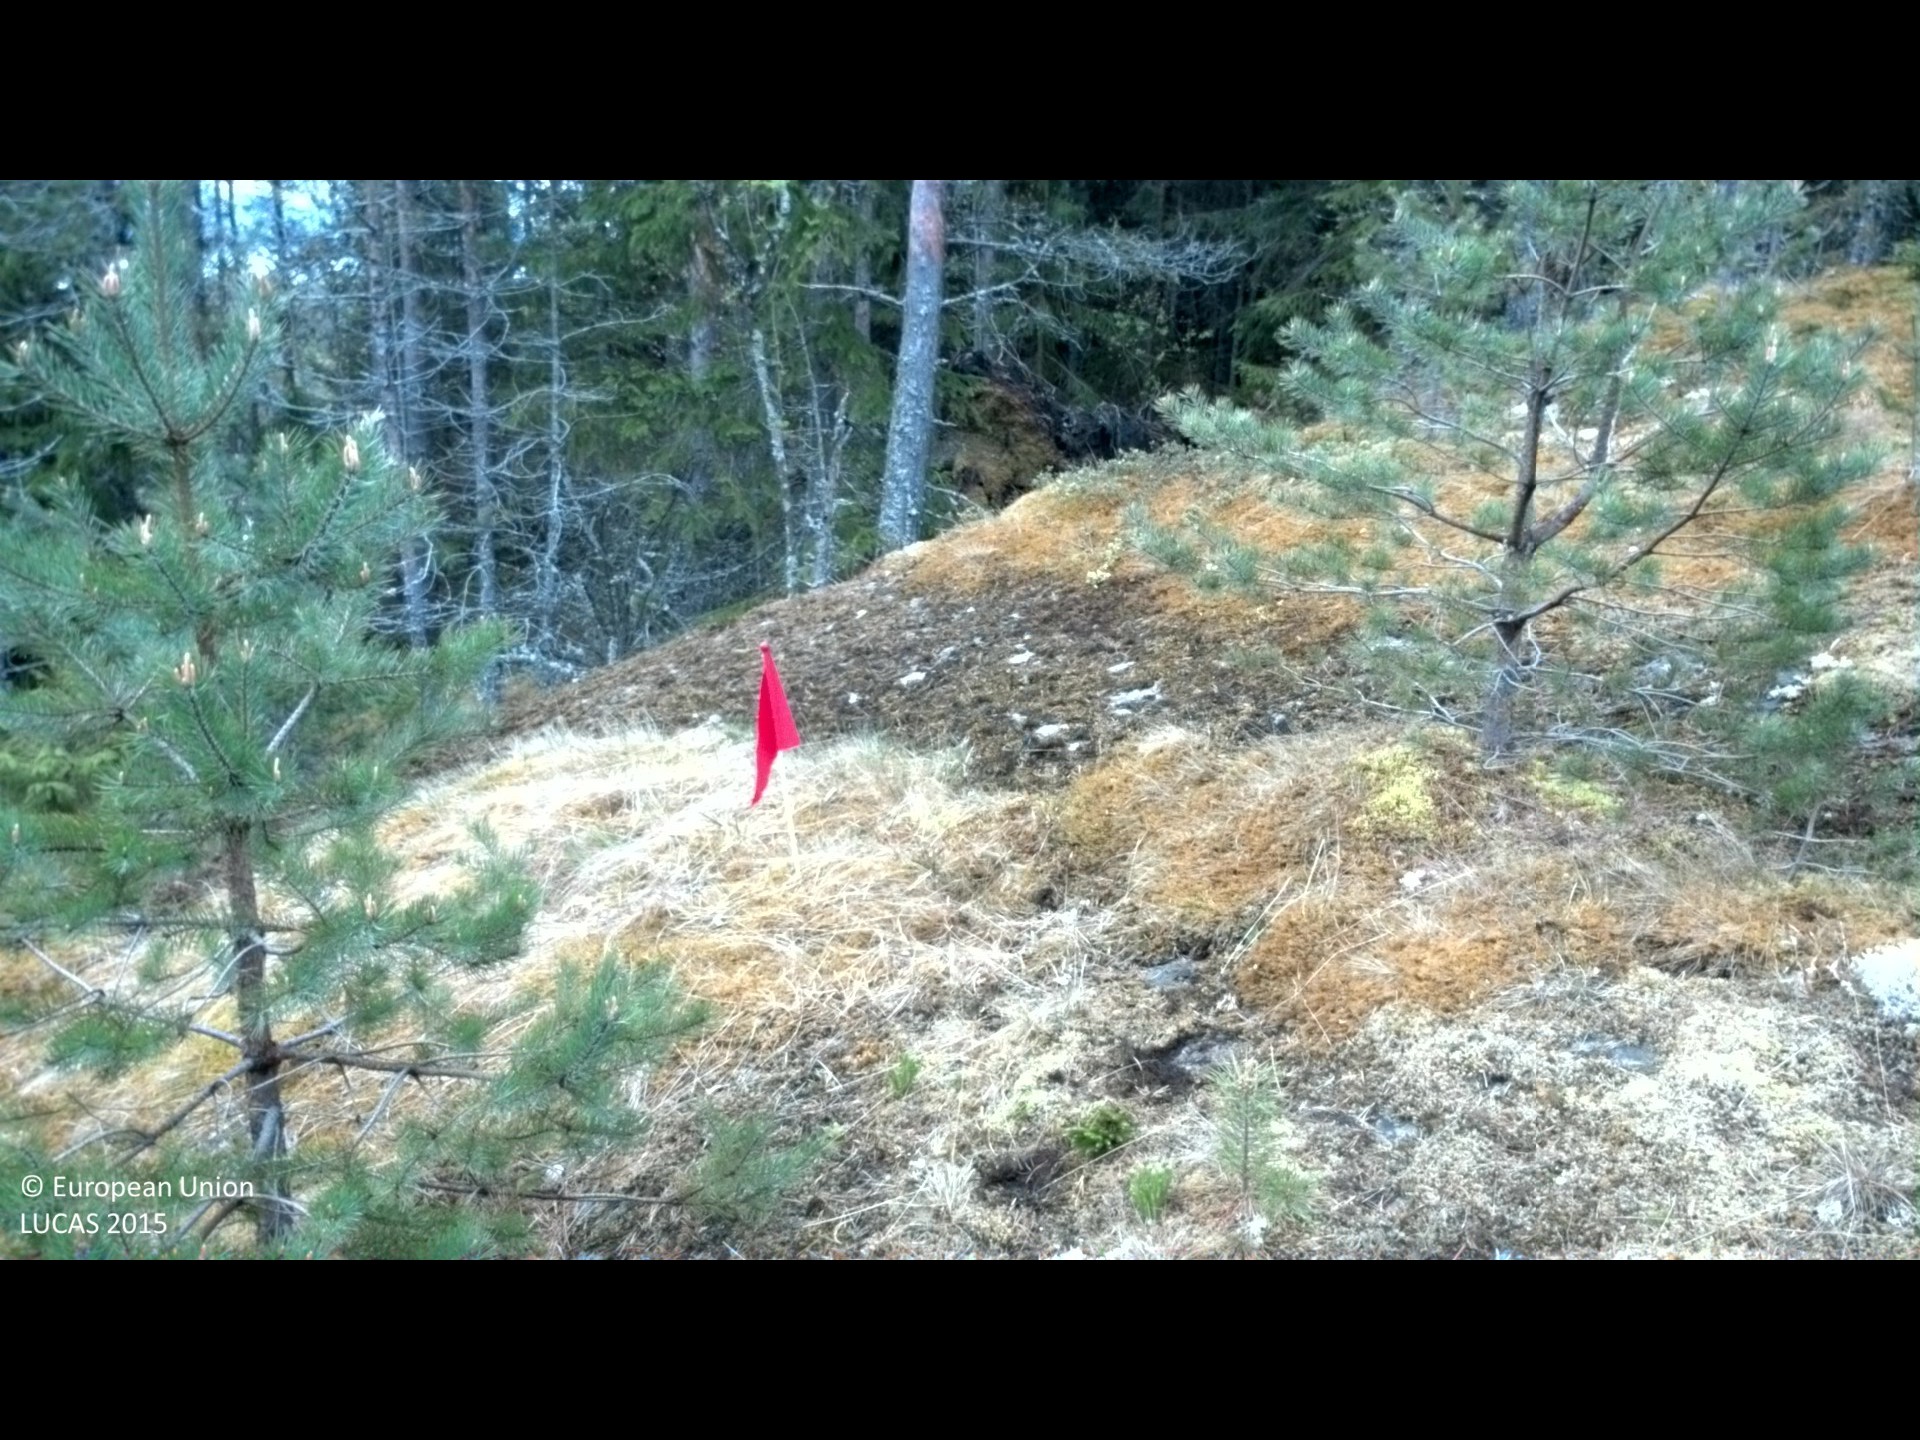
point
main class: Woodland
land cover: Pine dominated coniferous woodland
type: boreal forest
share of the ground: 50 - 75 %
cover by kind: coniferous forest trees 60 %, lichens and mosses 40 %
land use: Residential
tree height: > 5 m
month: May
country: SE
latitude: 62.9559
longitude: 17.7649
